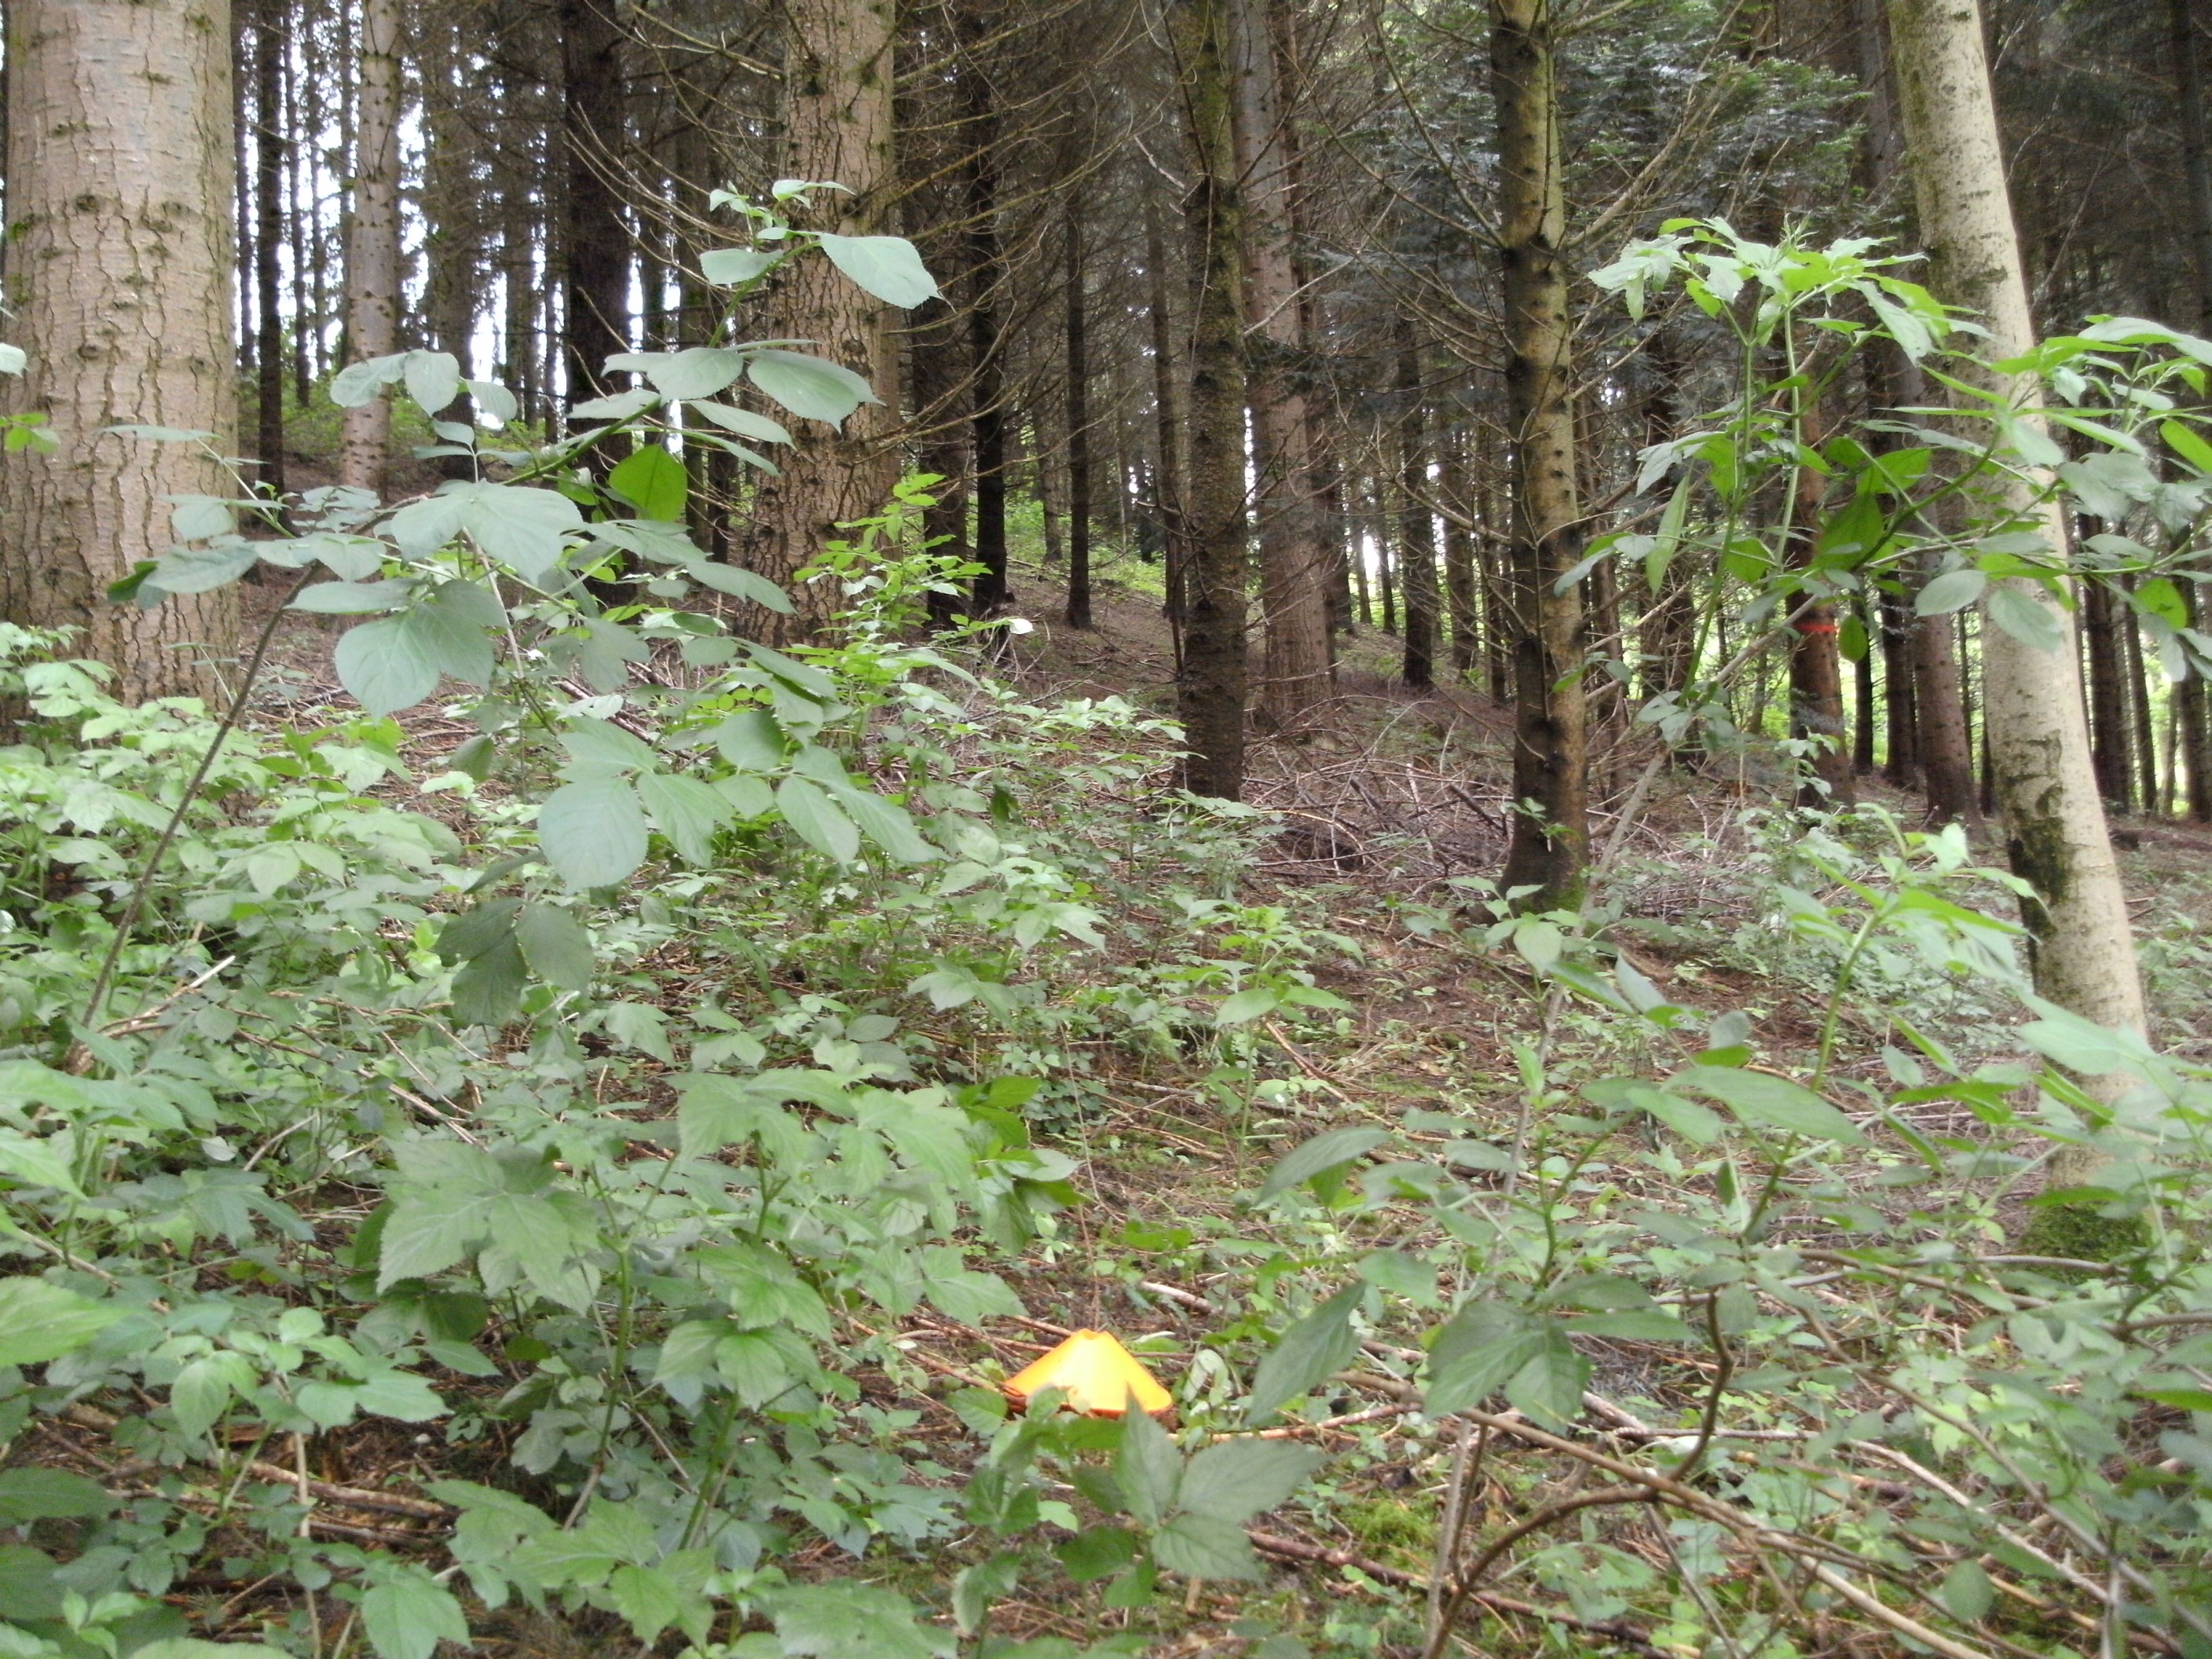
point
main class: Woodland
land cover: Other mixed woodland
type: hemiboreal forest and nemoral coniferous forest and mixed broadleaved-coniferous forest
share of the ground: > 75 %
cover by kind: coniferous forest trees 60 %, broadleaved forest trees 30 %, shrubs 5 %, herbaceous plants 5 %
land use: Forestry
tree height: > 5 m
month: May
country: AT
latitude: 48.1314
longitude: 14.0441
